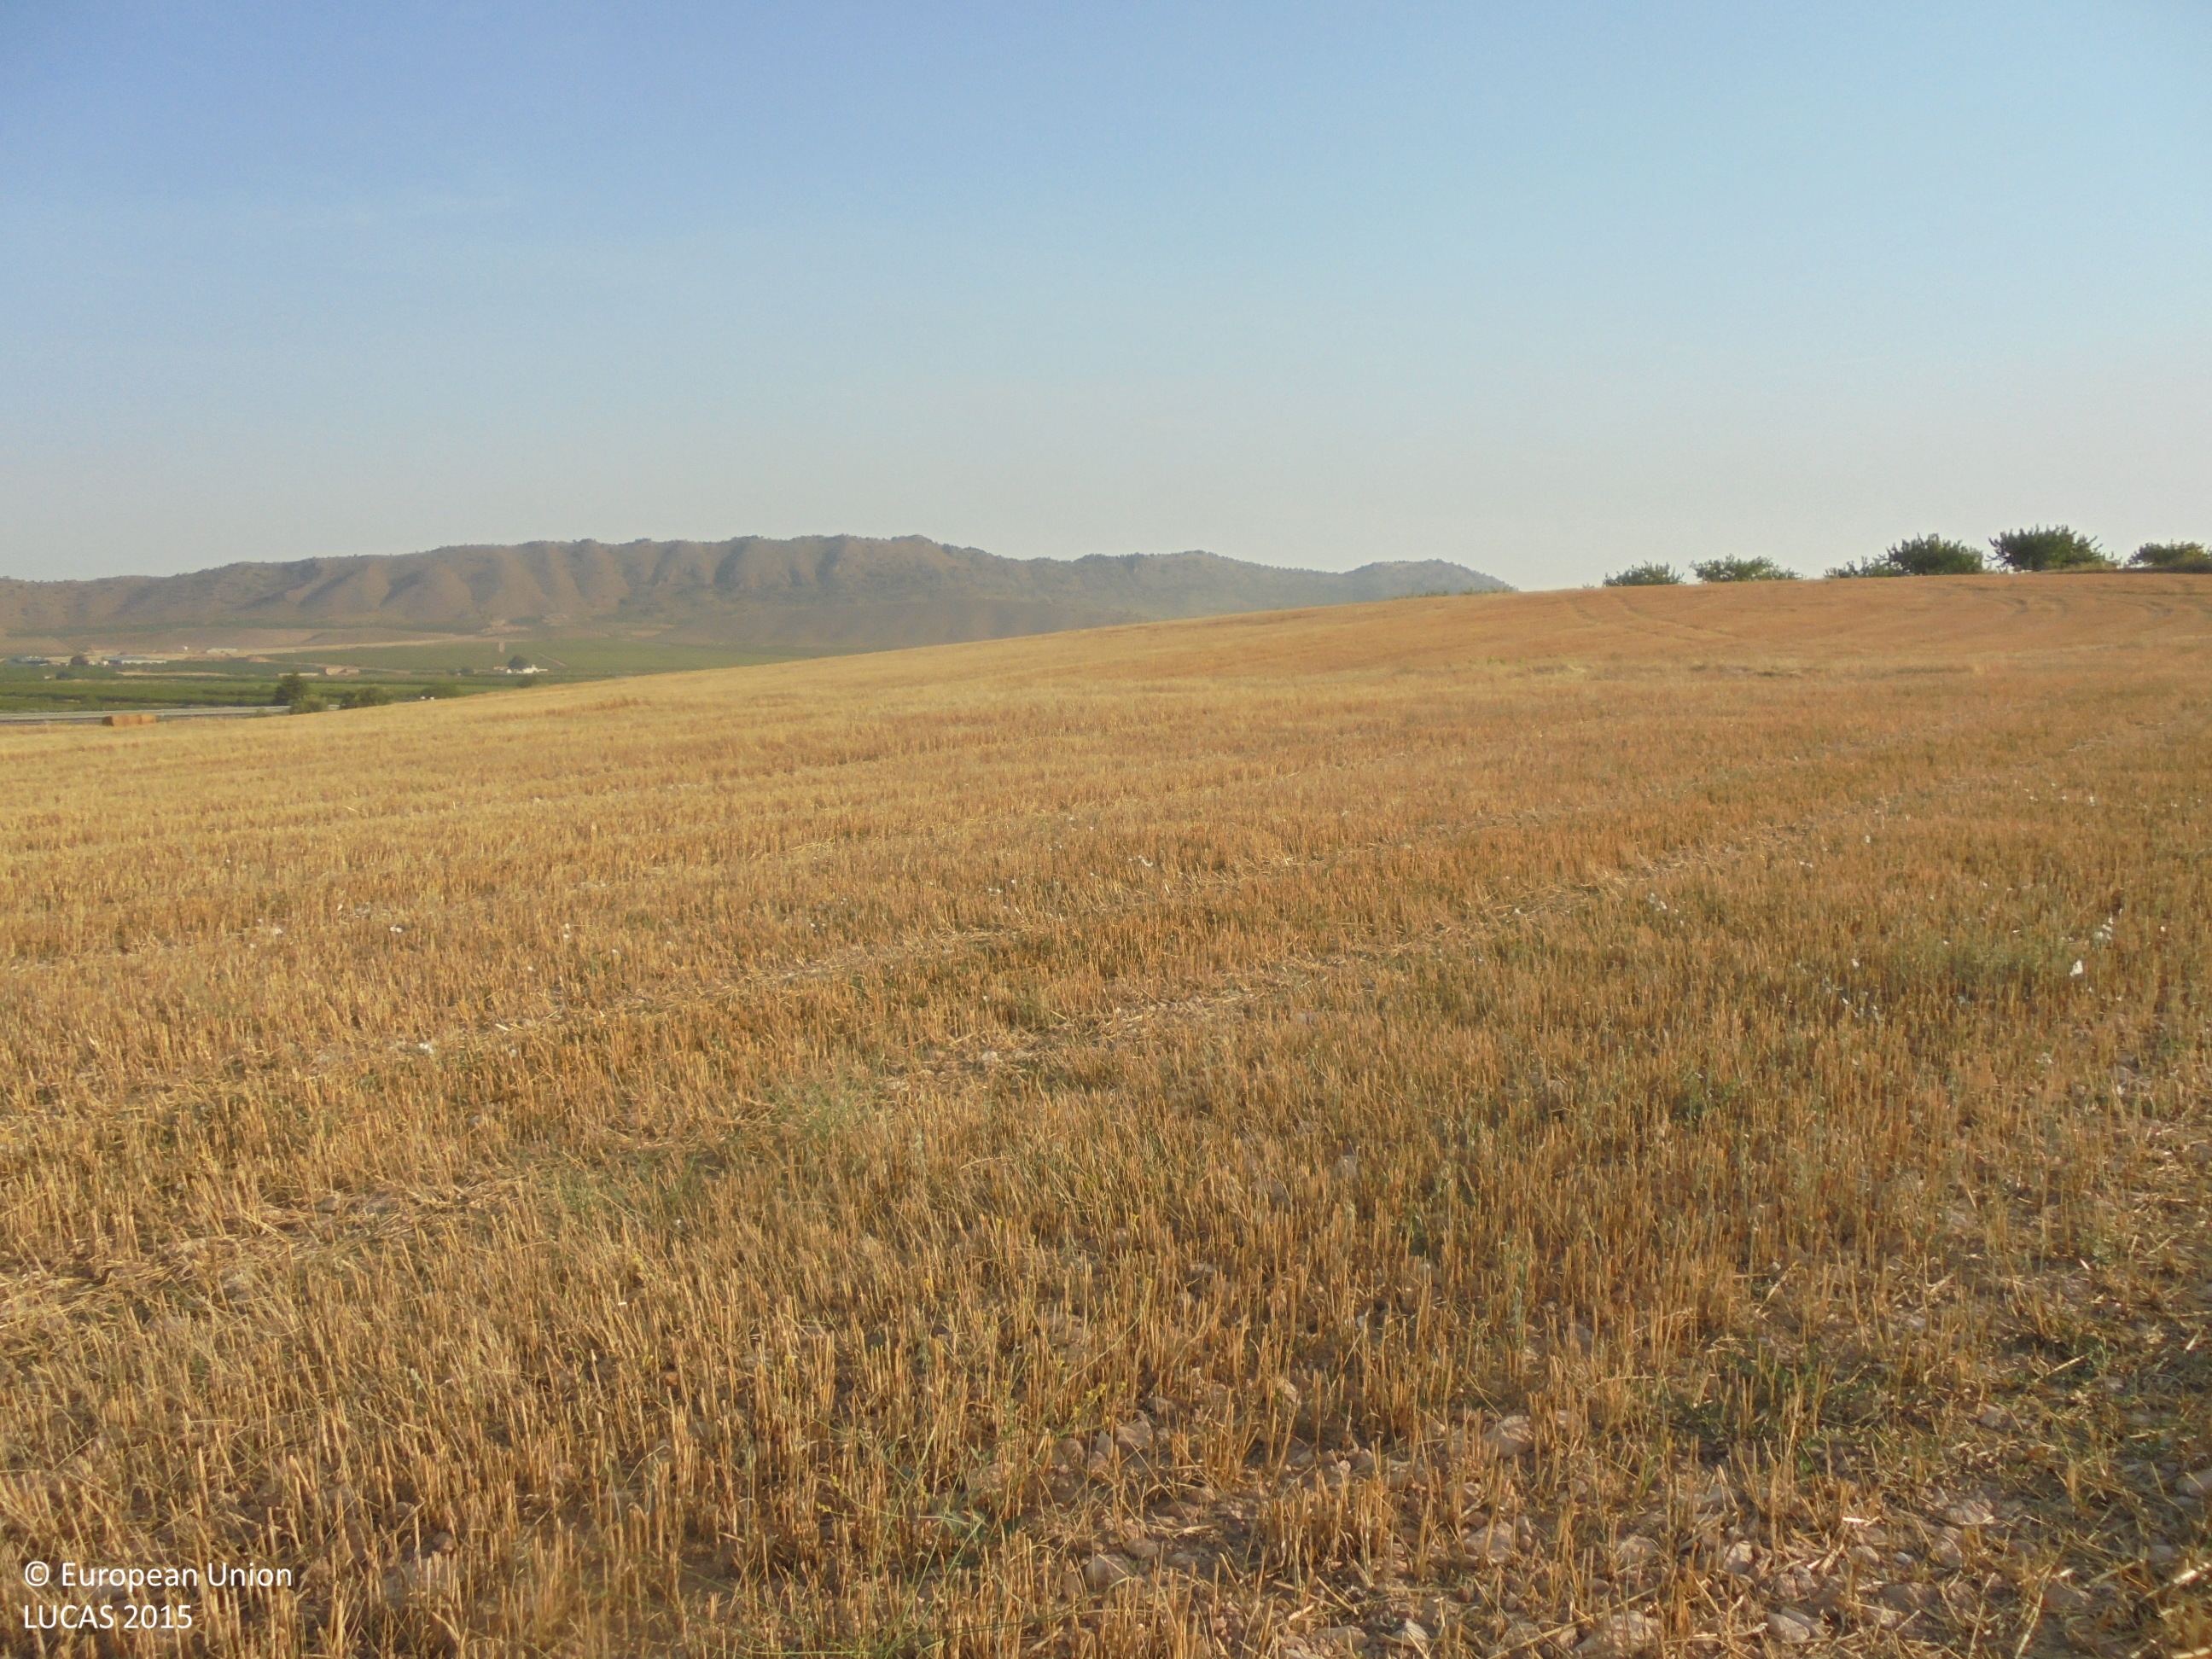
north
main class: Cropland
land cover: Oats
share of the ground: < 10 %
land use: Agriculture (excluding fallow land and kitchen gardens)
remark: Harvested field
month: July
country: ES
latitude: 38.6175
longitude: -1.6749
